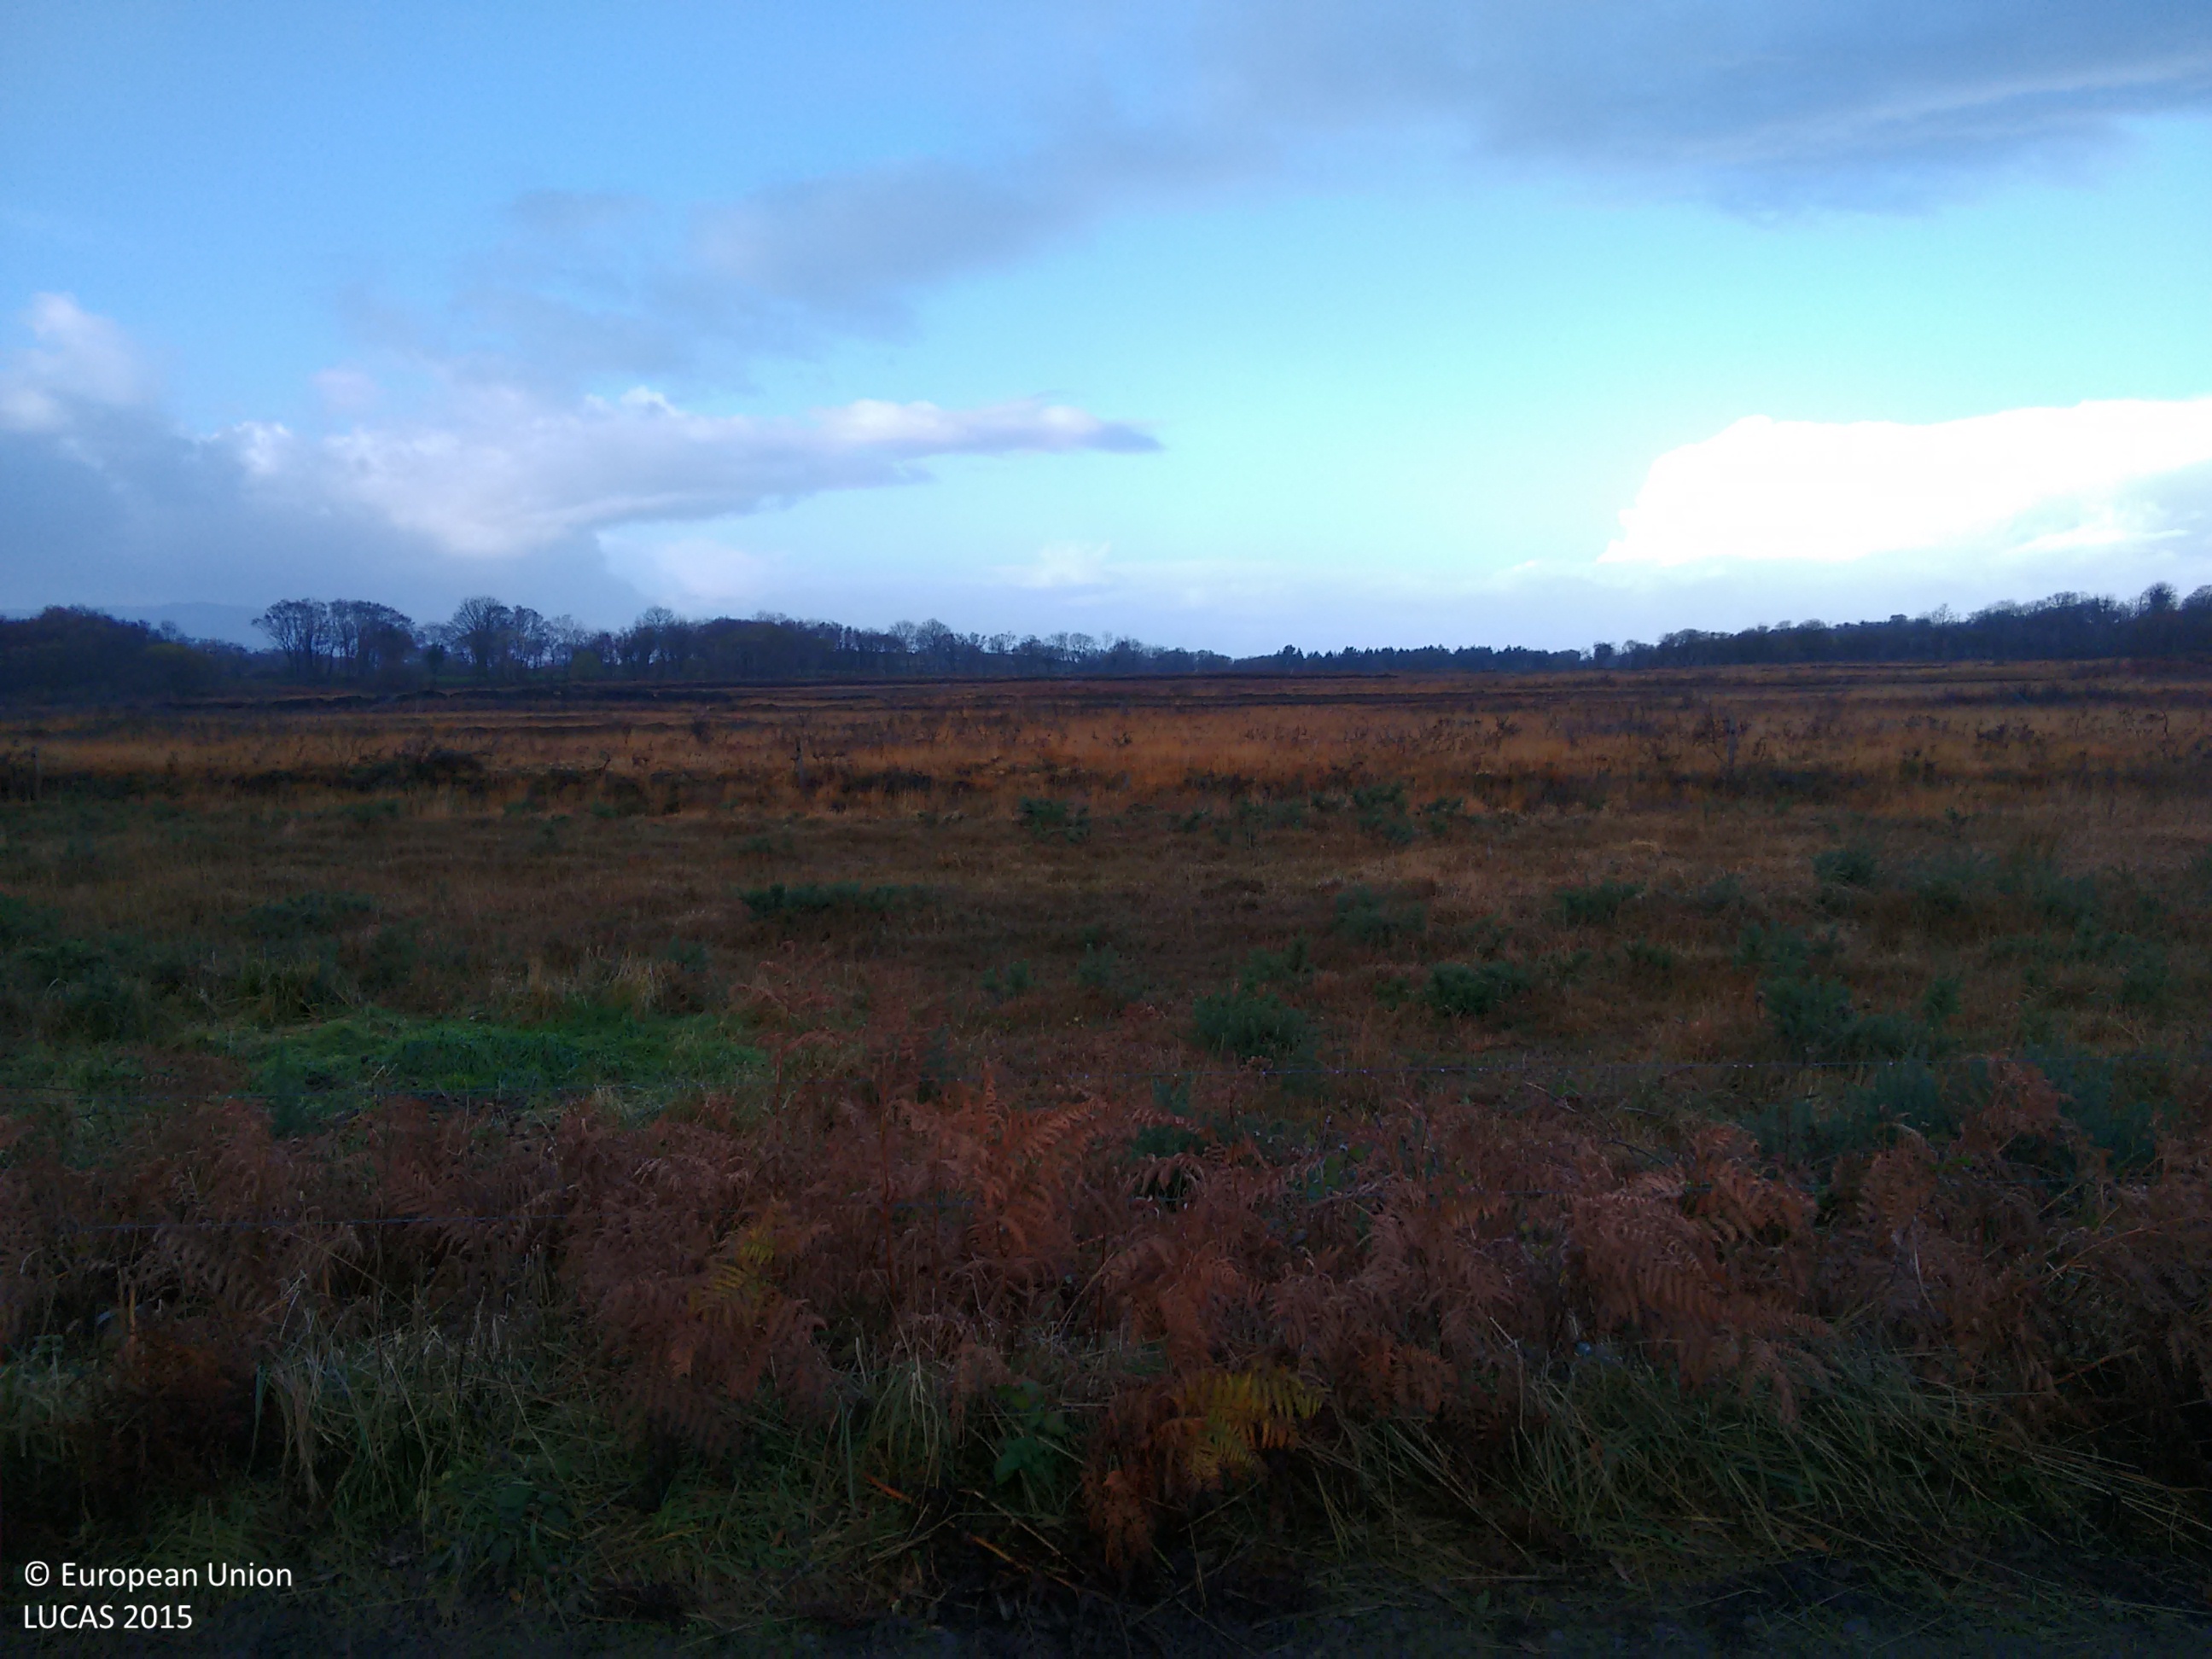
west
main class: Grassland
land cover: Grassland without tree/shrub cover
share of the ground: > 75 %
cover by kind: herbaceous plants 100 %
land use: Agriculture (excluding fallow land and kitchen gardens)
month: November
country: IE
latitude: 54.4732
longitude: -8.1240
